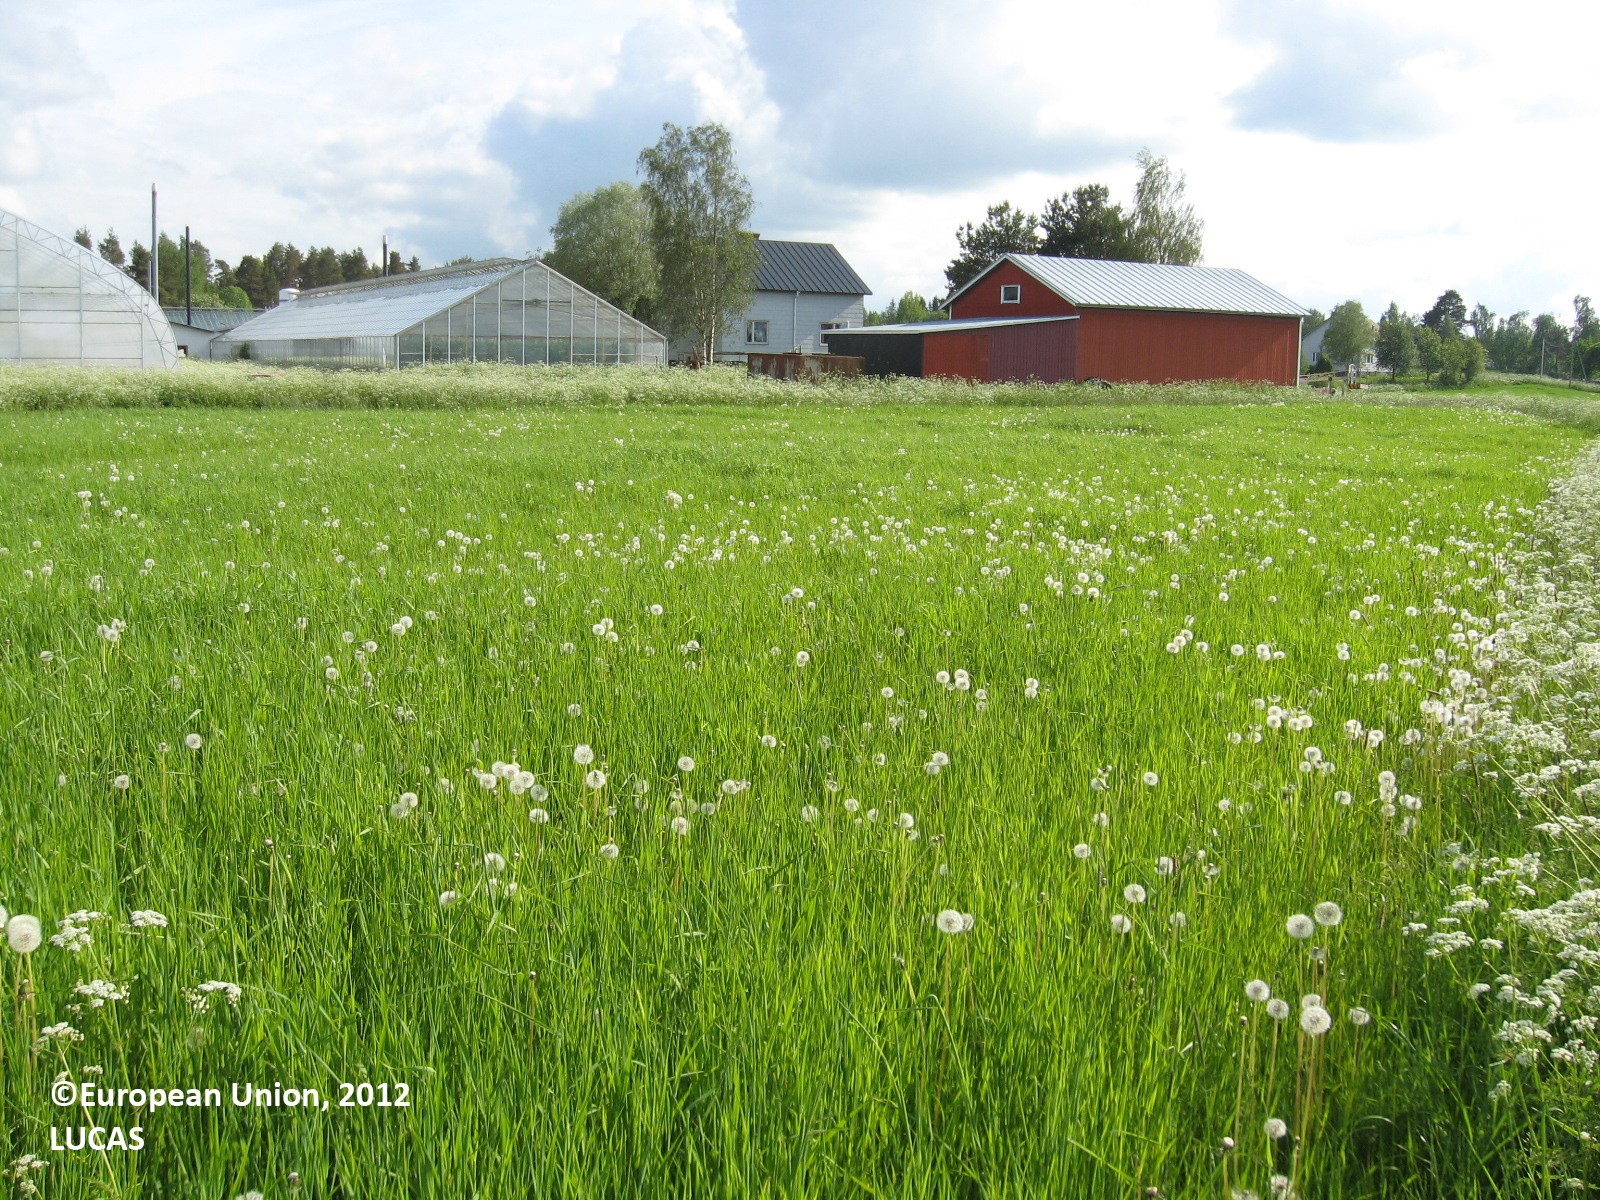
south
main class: Cropland
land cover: Temporary grasslands
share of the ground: > 75 %
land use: Agriculture (excluding fallow land and kitchen gardens)
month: June
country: FI
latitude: 62.9086
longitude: 21.6345
